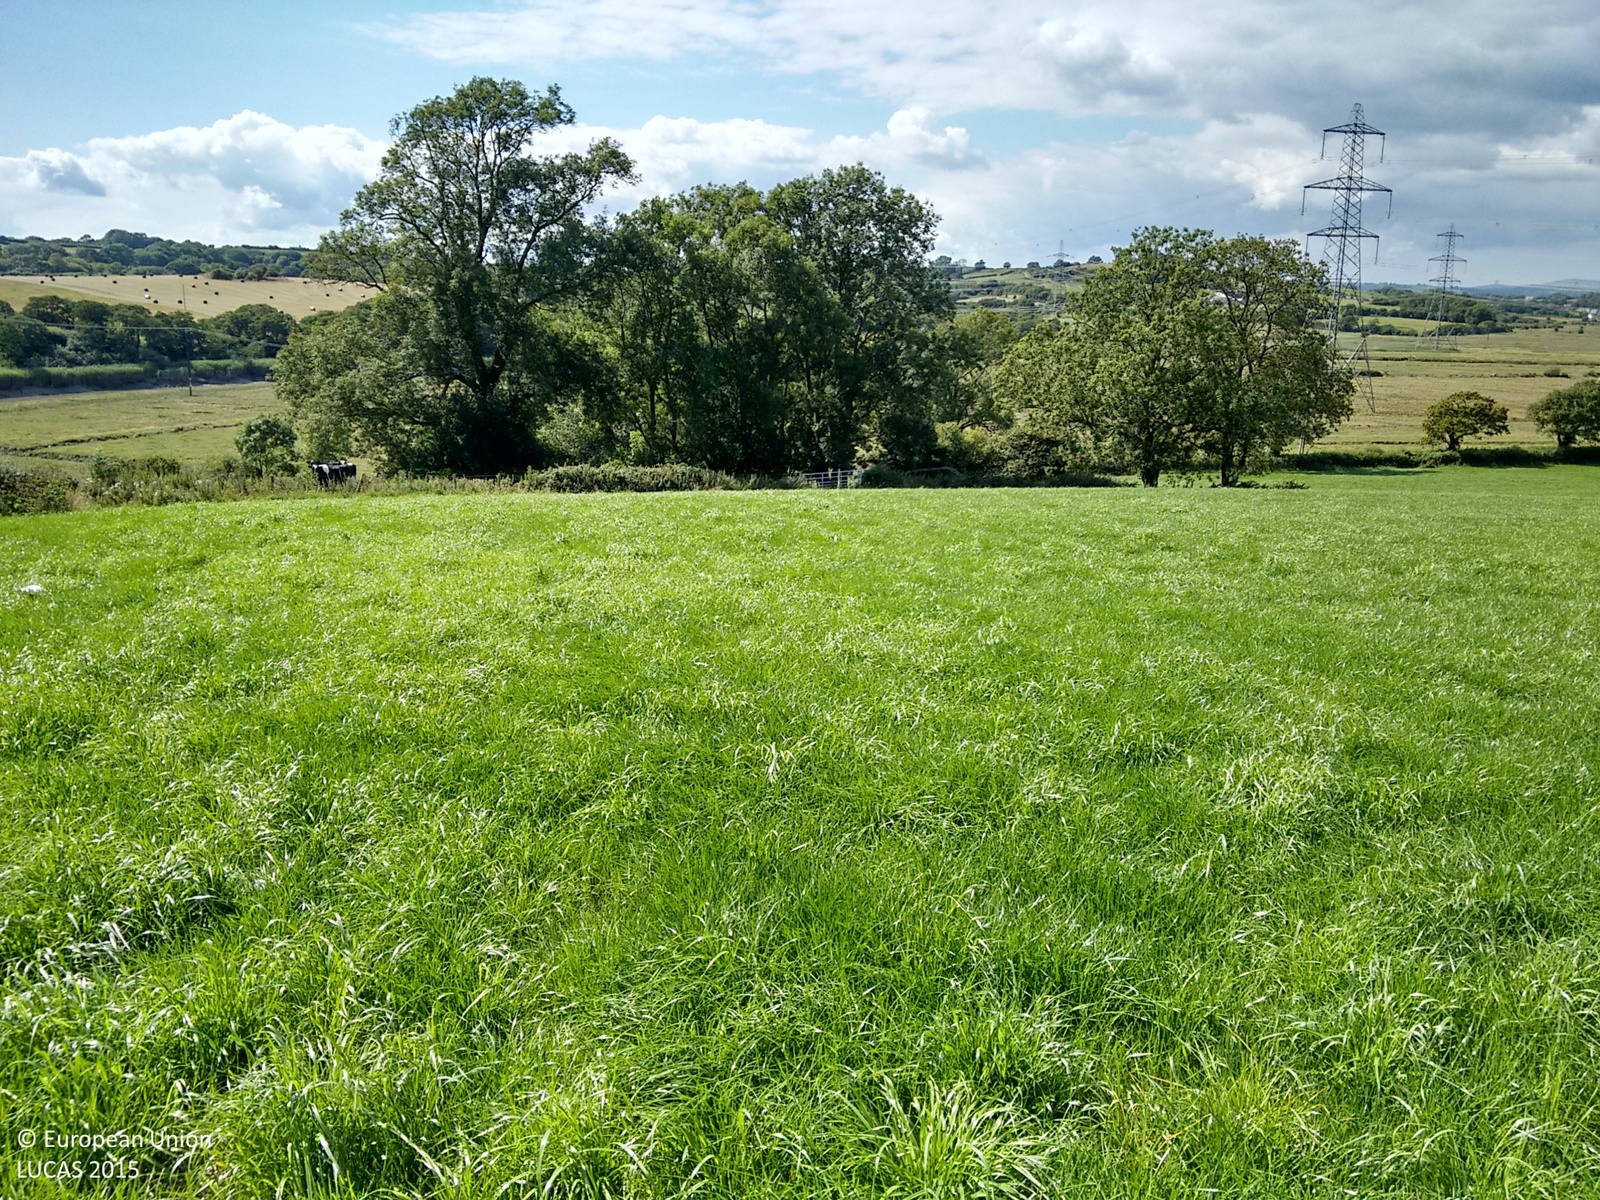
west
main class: Grassland
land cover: Grassland without tree/shrub cover
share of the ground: > 75 %
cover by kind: herbaceous plants 100 %
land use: Agriculture (excluding fallow land and kitchen gardens)
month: August
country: GB
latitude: 51.7947
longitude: -4.4738
